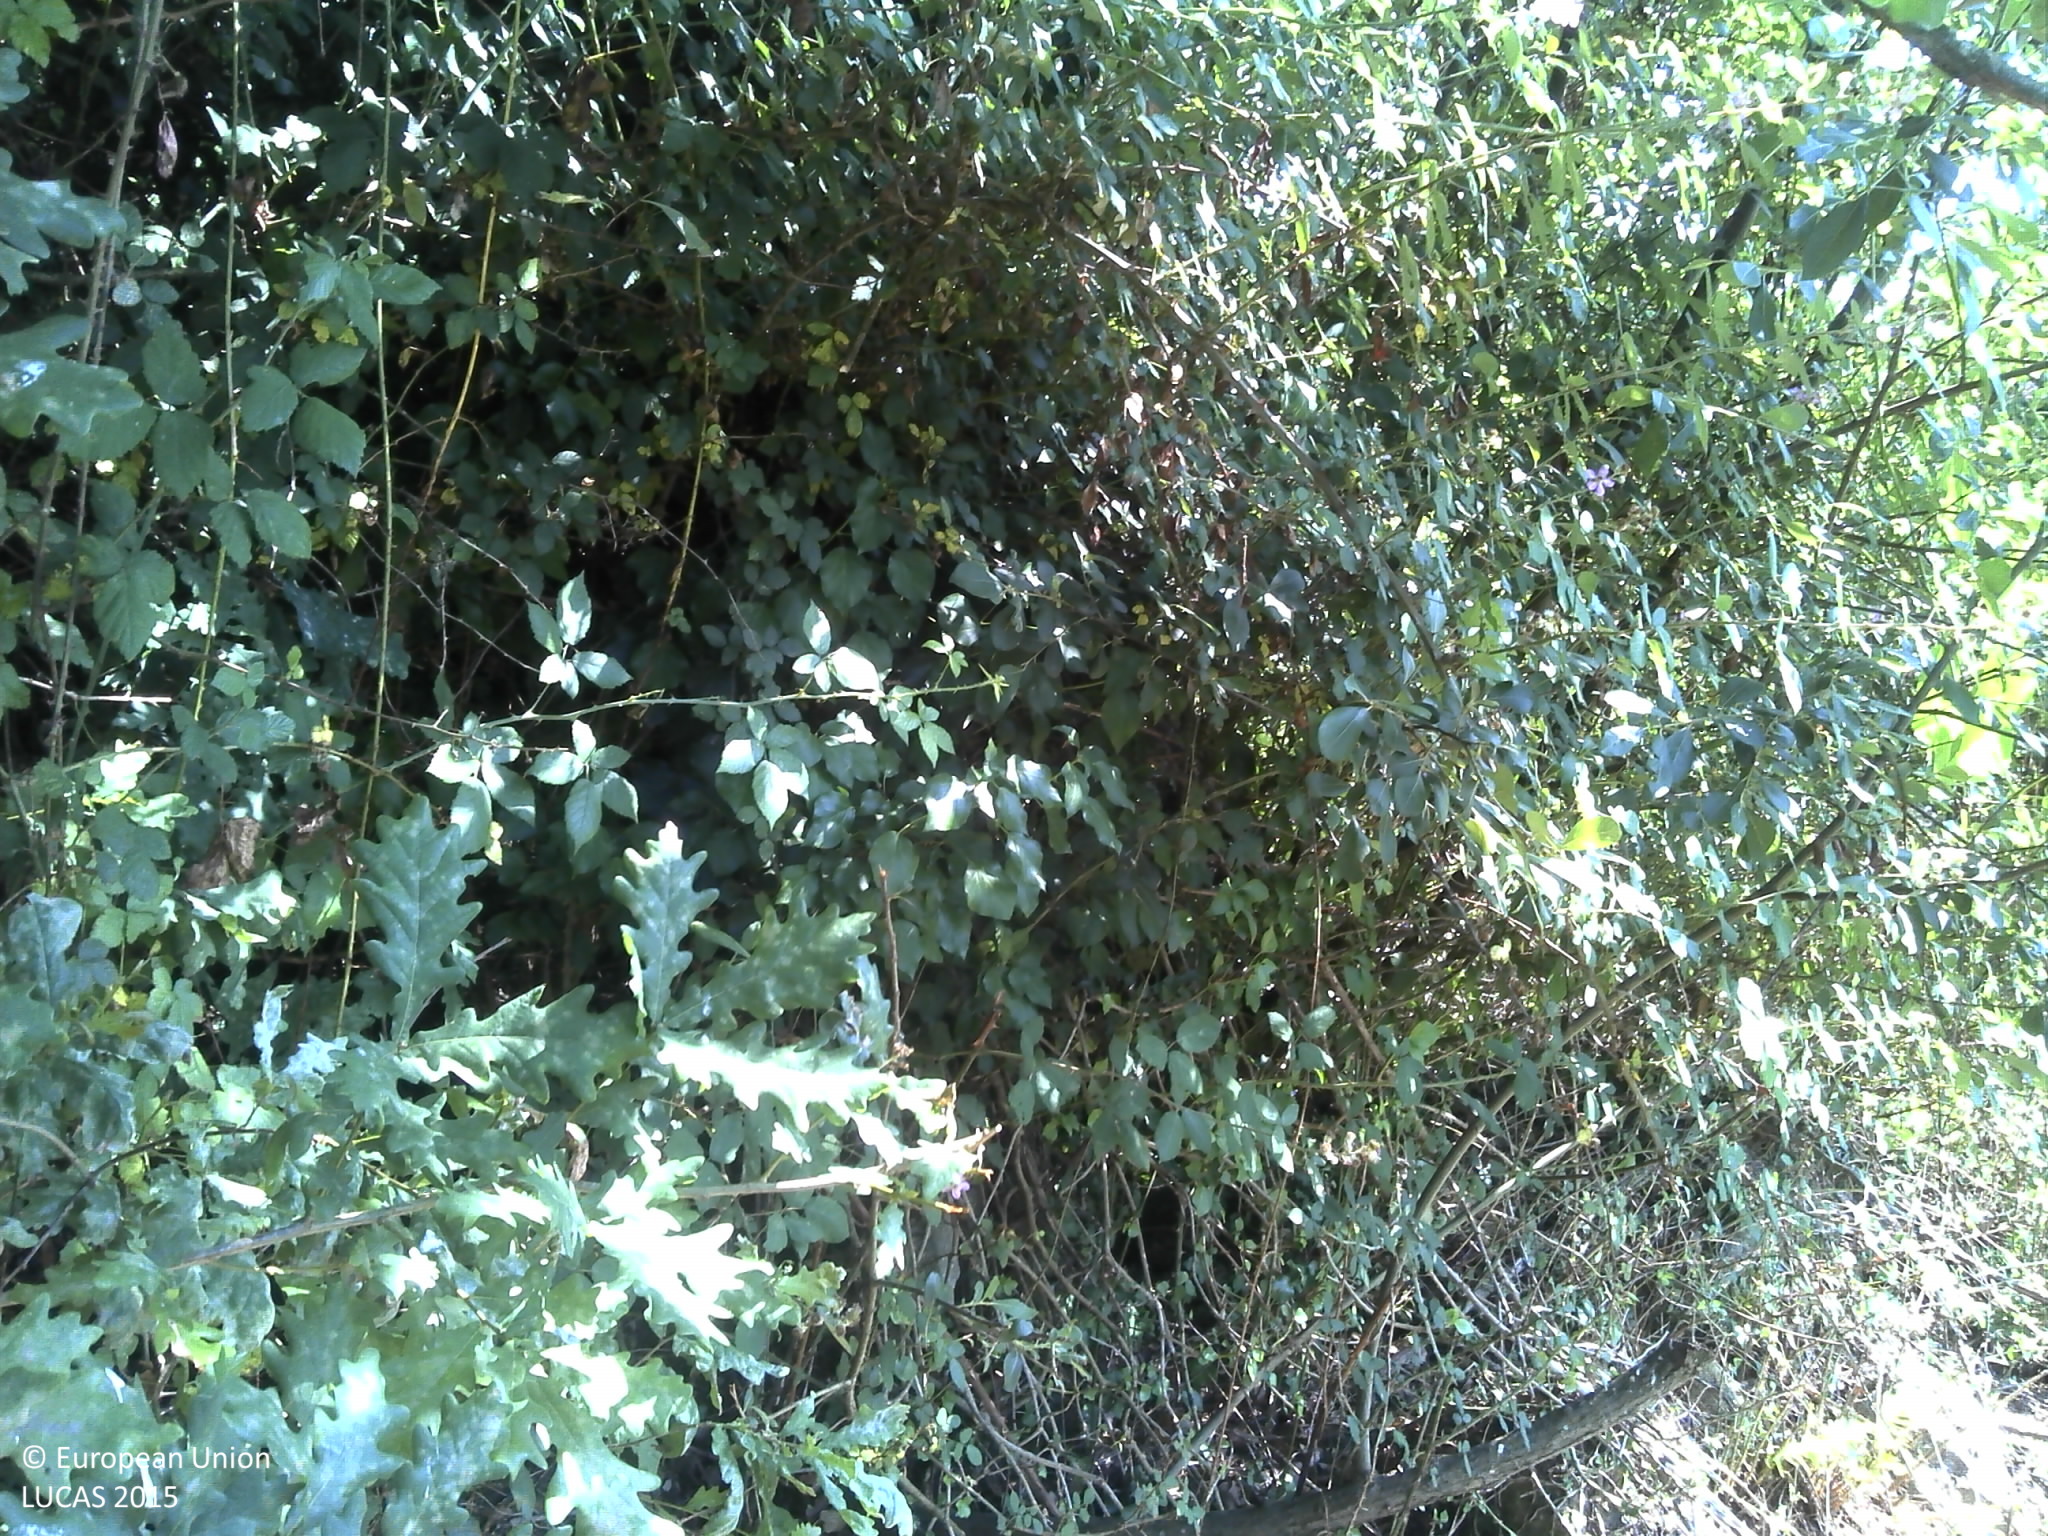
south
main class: Woodland
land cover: Broadleaved woodland
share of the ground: 25 - 50 %
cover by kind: broadleaved forest trees 50 %, shrubs 30 %, consolidated bare surface 10 %, unconsolidated bare surface 10 %
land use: Semi-natural and natural areas not in use
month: June
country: PT
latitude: 40.6794
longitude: -8.2721
